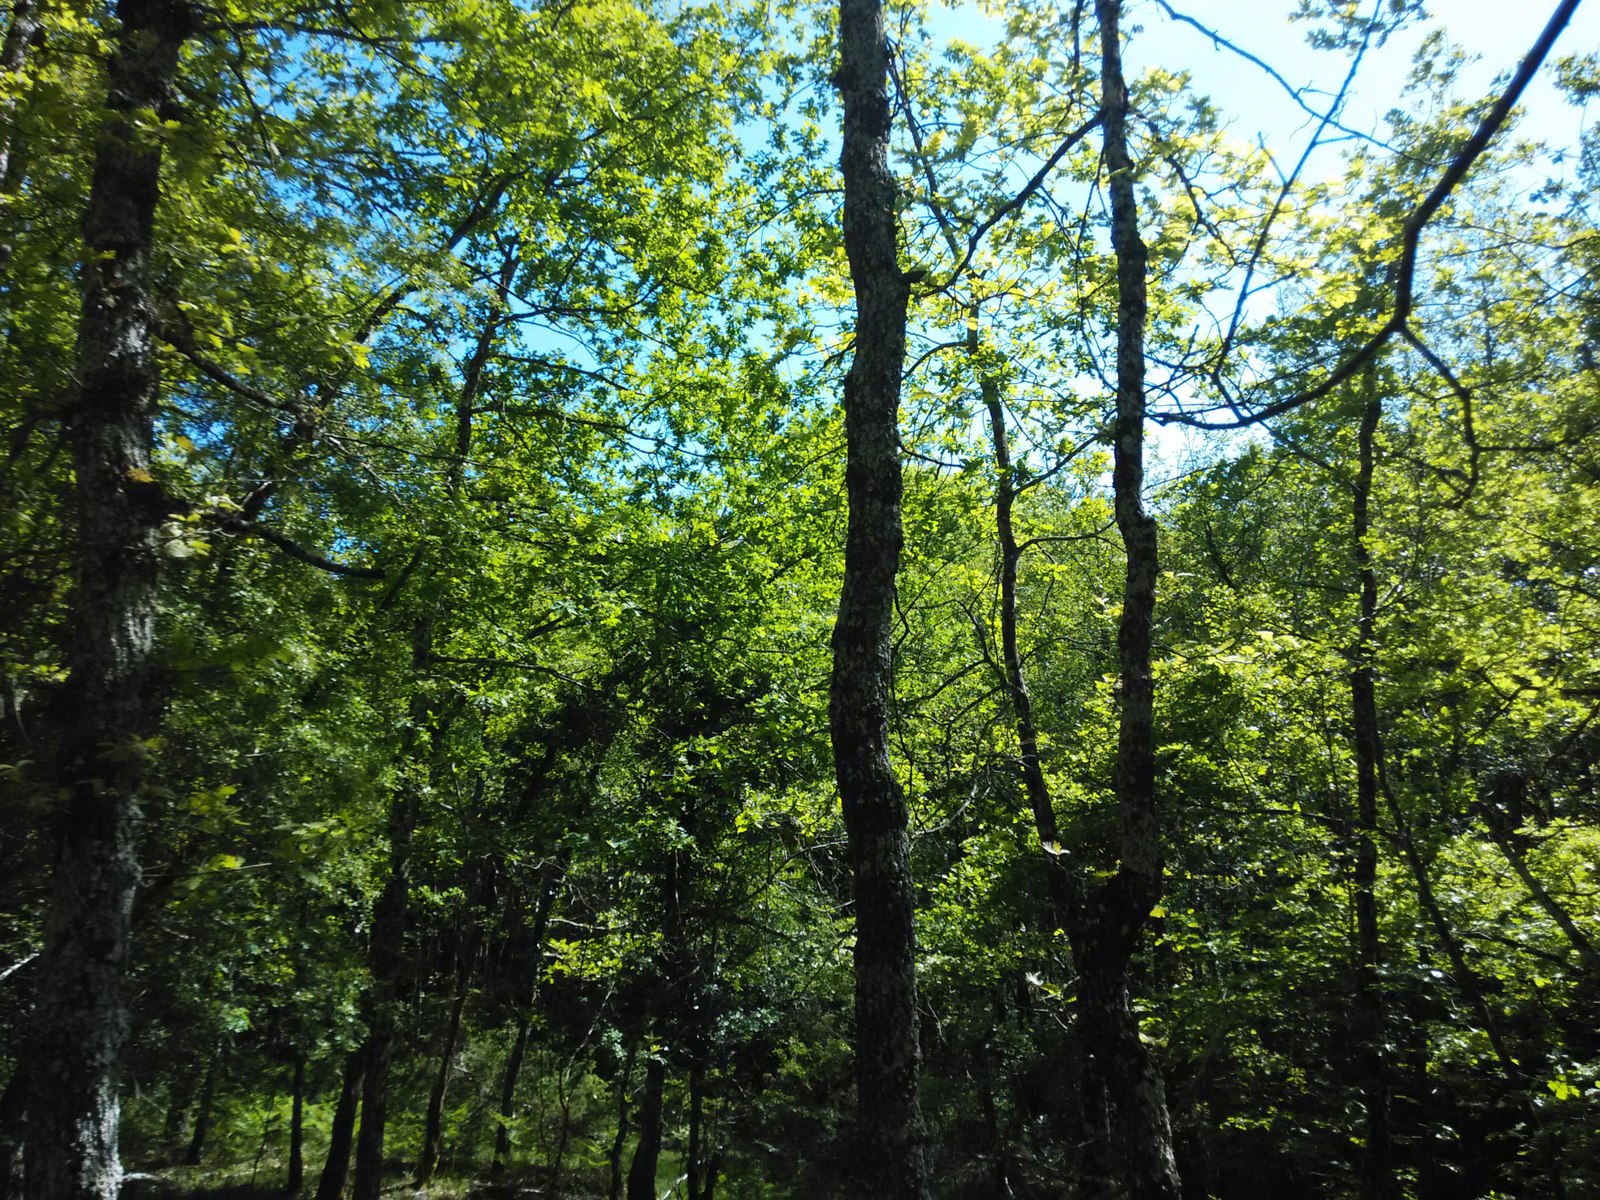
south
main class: Woodland
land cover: Broadleaved woodland
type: acidophilous oak and oak-birch forest
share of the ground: > 75 %
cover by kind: broadleaved forest trees 75 %, shrubs 15 %, herbaceous plants 10 %
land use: Forestry
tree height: > 5 m
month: May
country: ES
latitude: 42.6637
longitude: -2.4793
